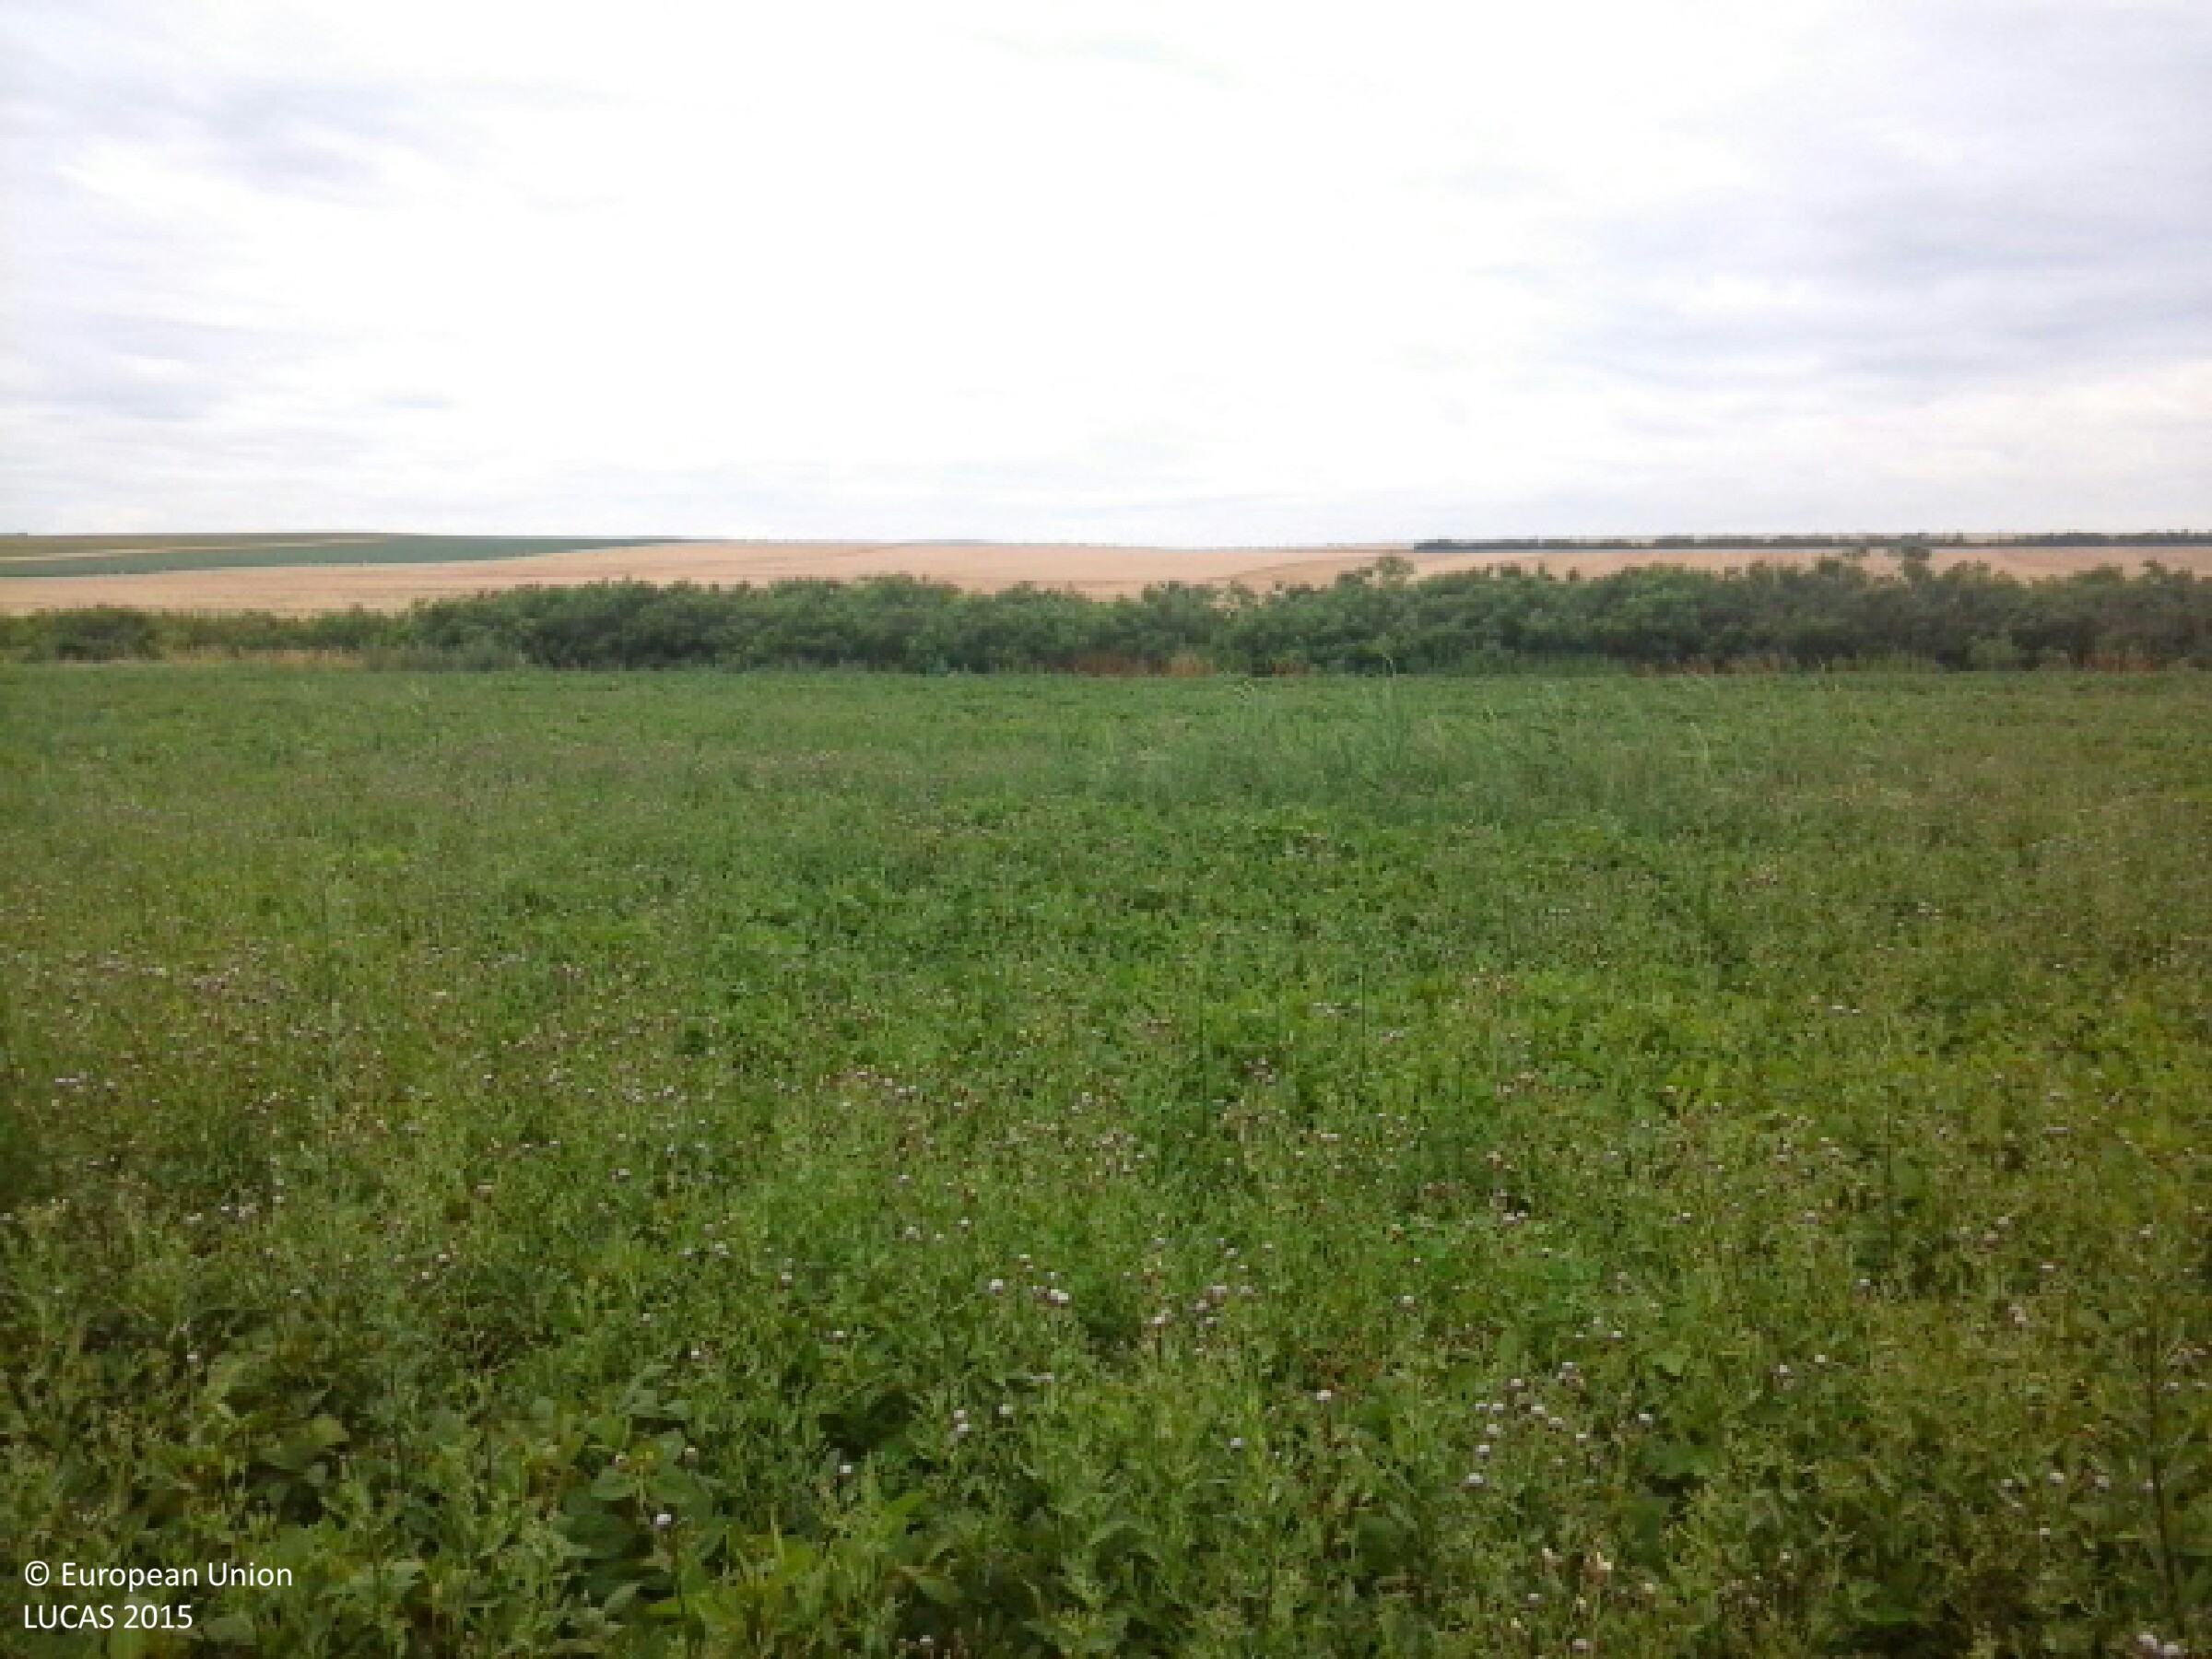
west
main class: Grassland
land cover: Spontaneously vegetated surfaces
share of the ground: > 75 %
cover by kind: herbaceous plants 100 %
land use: Abandoned areas
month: July
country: HU
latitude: 48.2550
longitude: 21.1536
